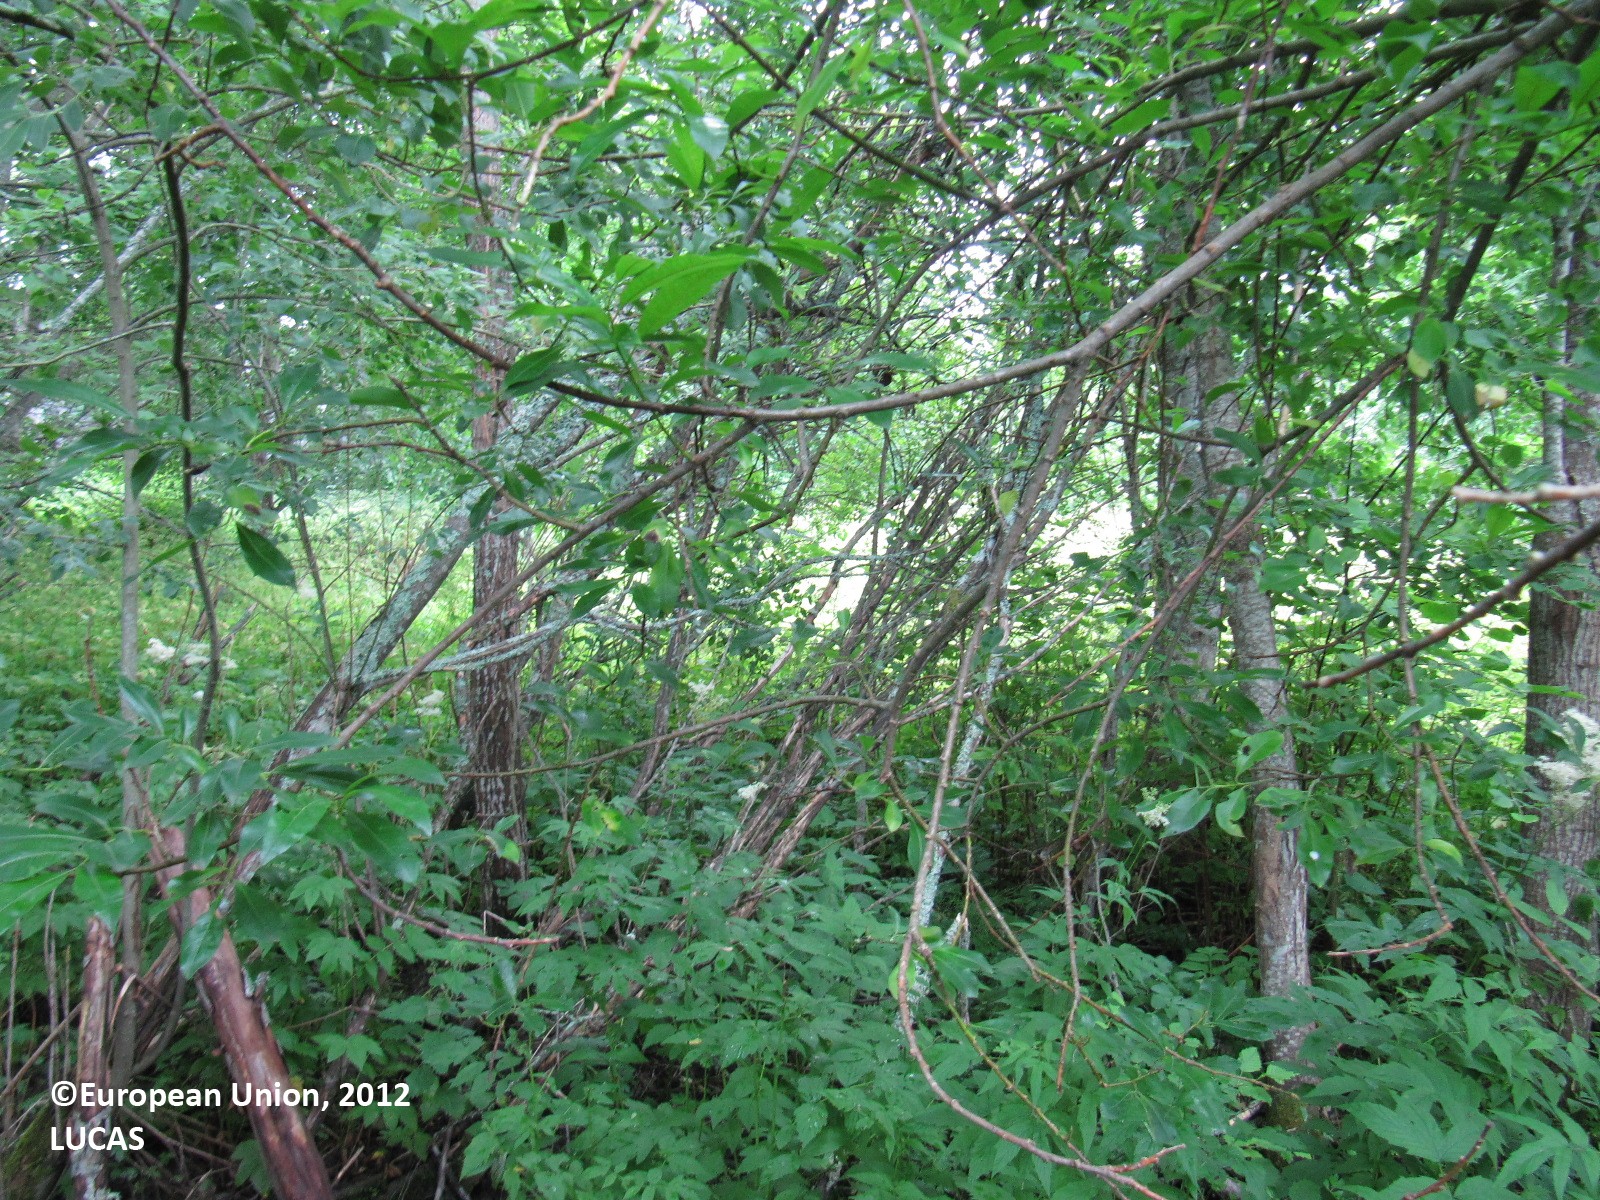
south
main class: Woodland
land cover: Broadleaved woodland
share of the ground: > 75 %
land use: Forestry
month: July
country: FI
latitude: 60.3821
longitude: 23.9363
